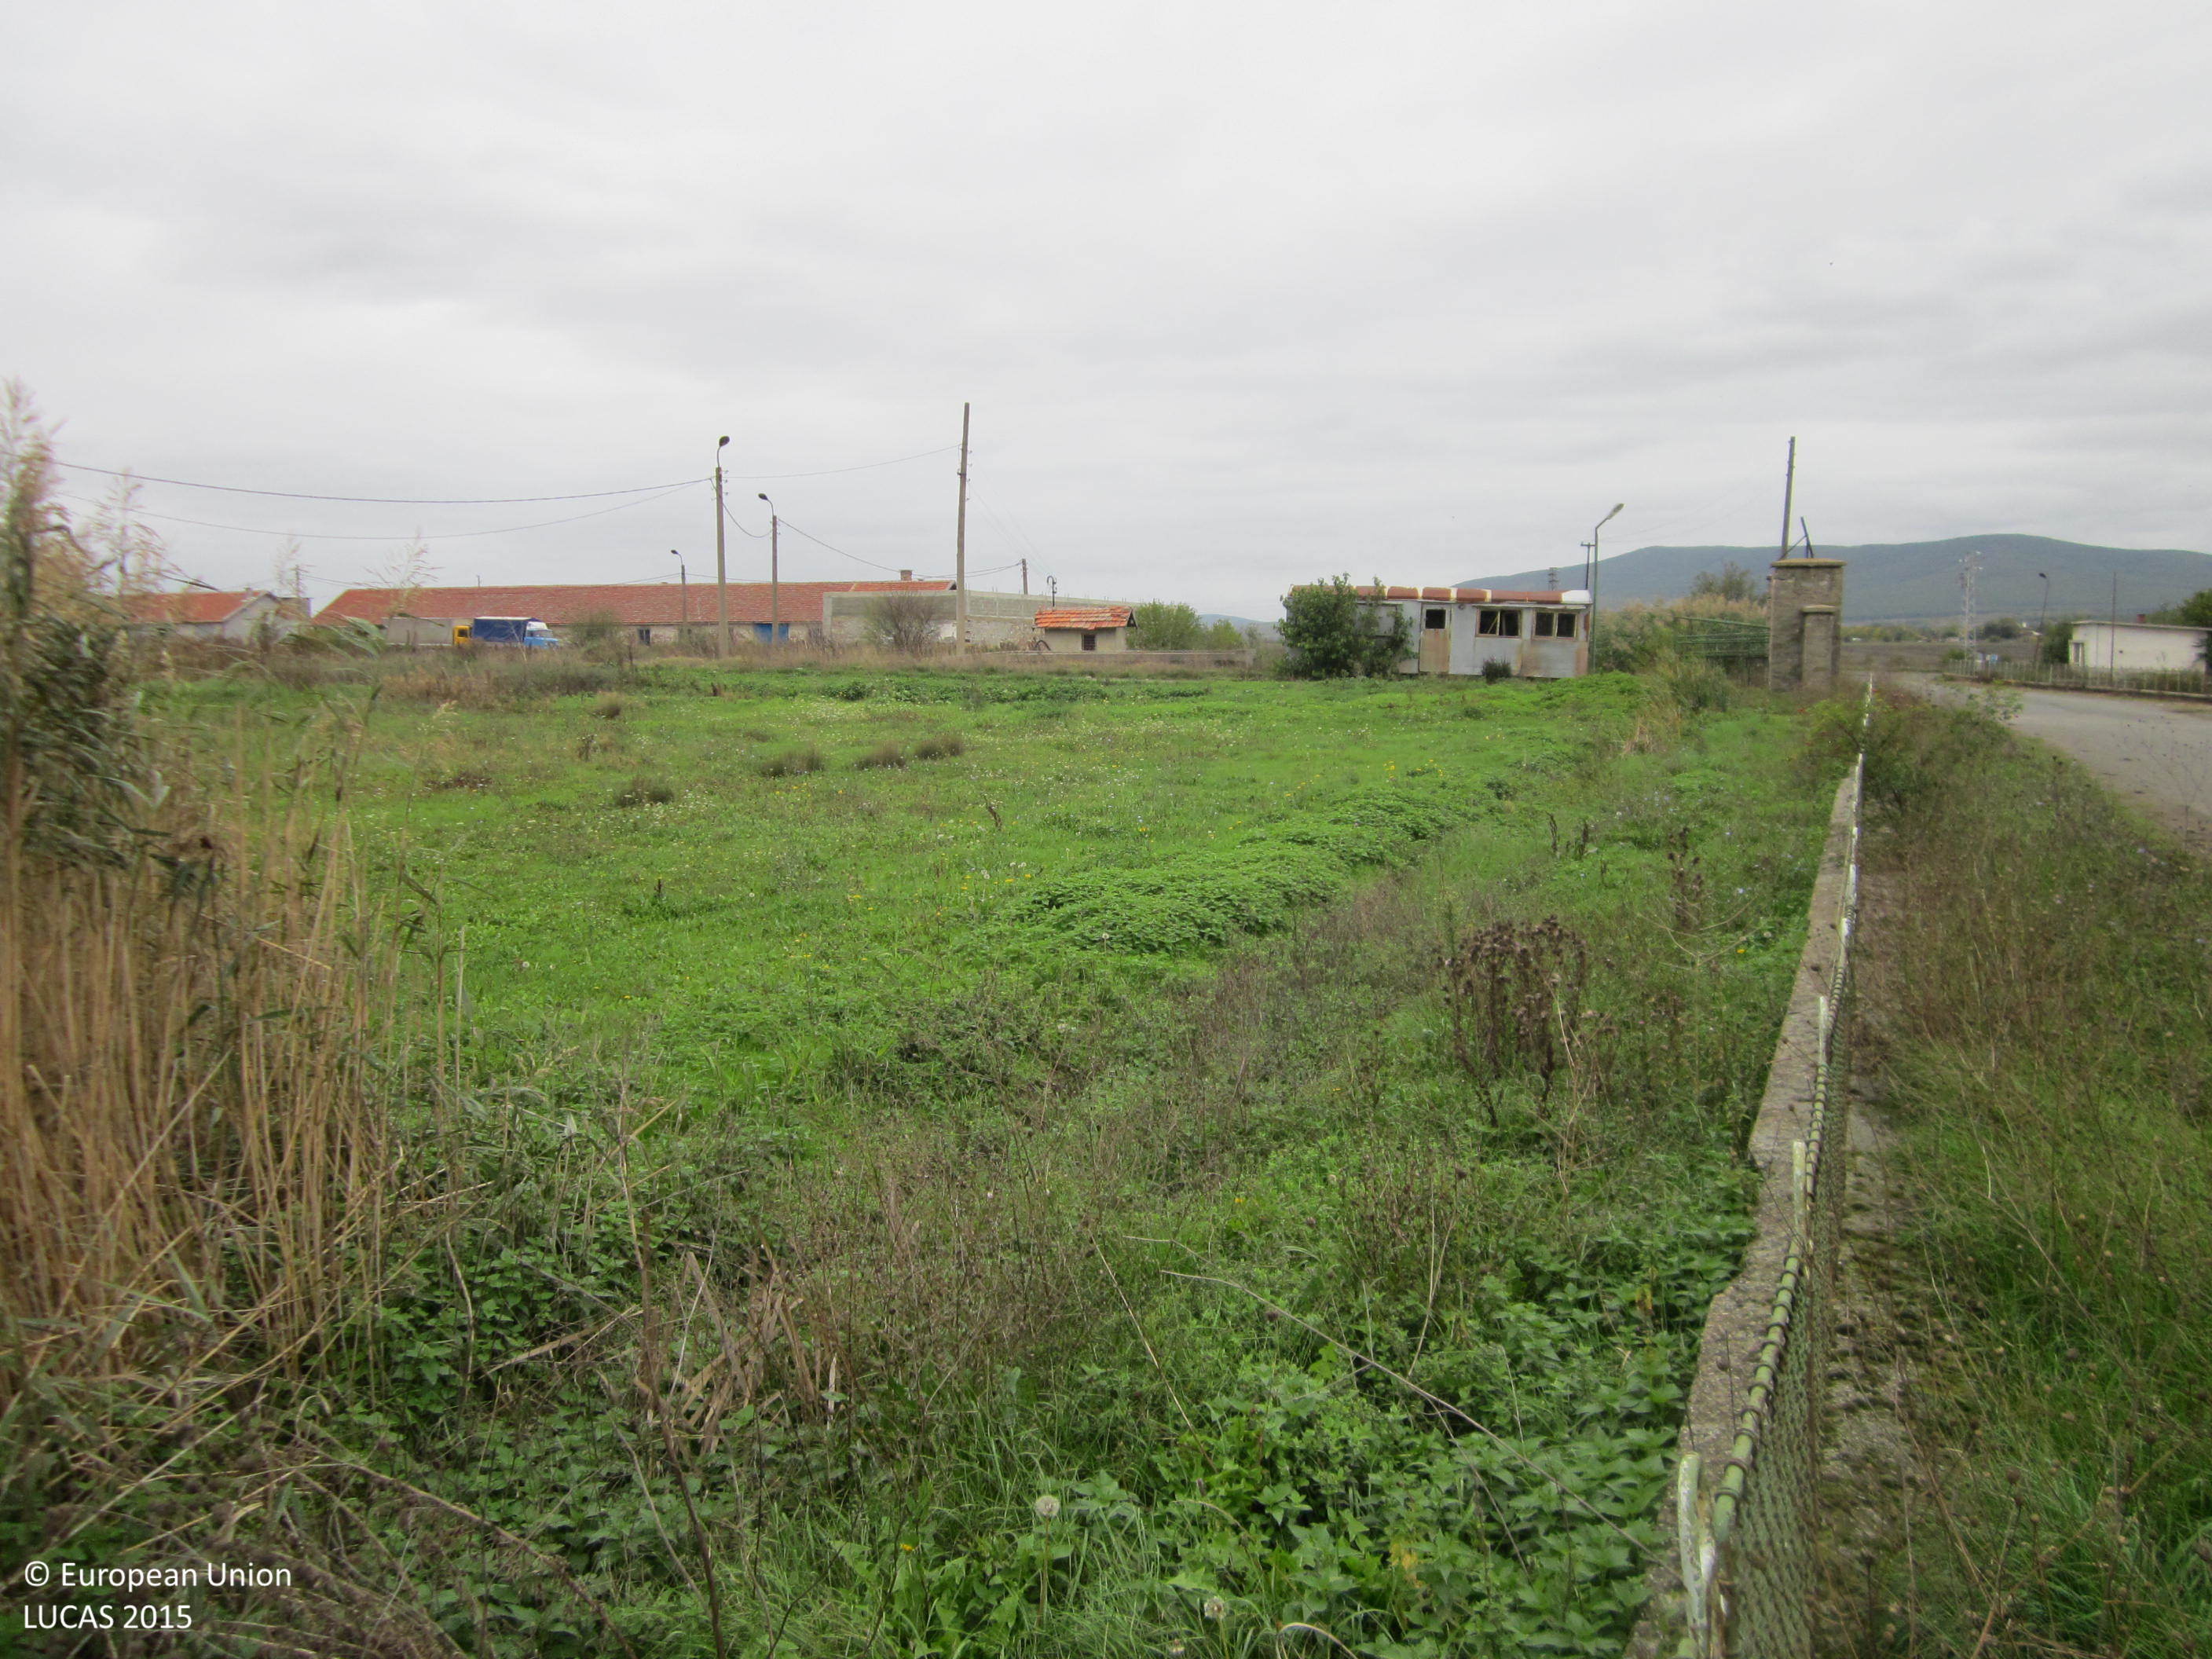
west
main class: Grassland
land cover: Spontaneously vegetated surfaces
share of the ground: > 75 %
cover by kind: herbaceous plants 100 %
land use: Fallow land
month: October
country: BG
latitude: 42.7165
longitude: 27.0951
